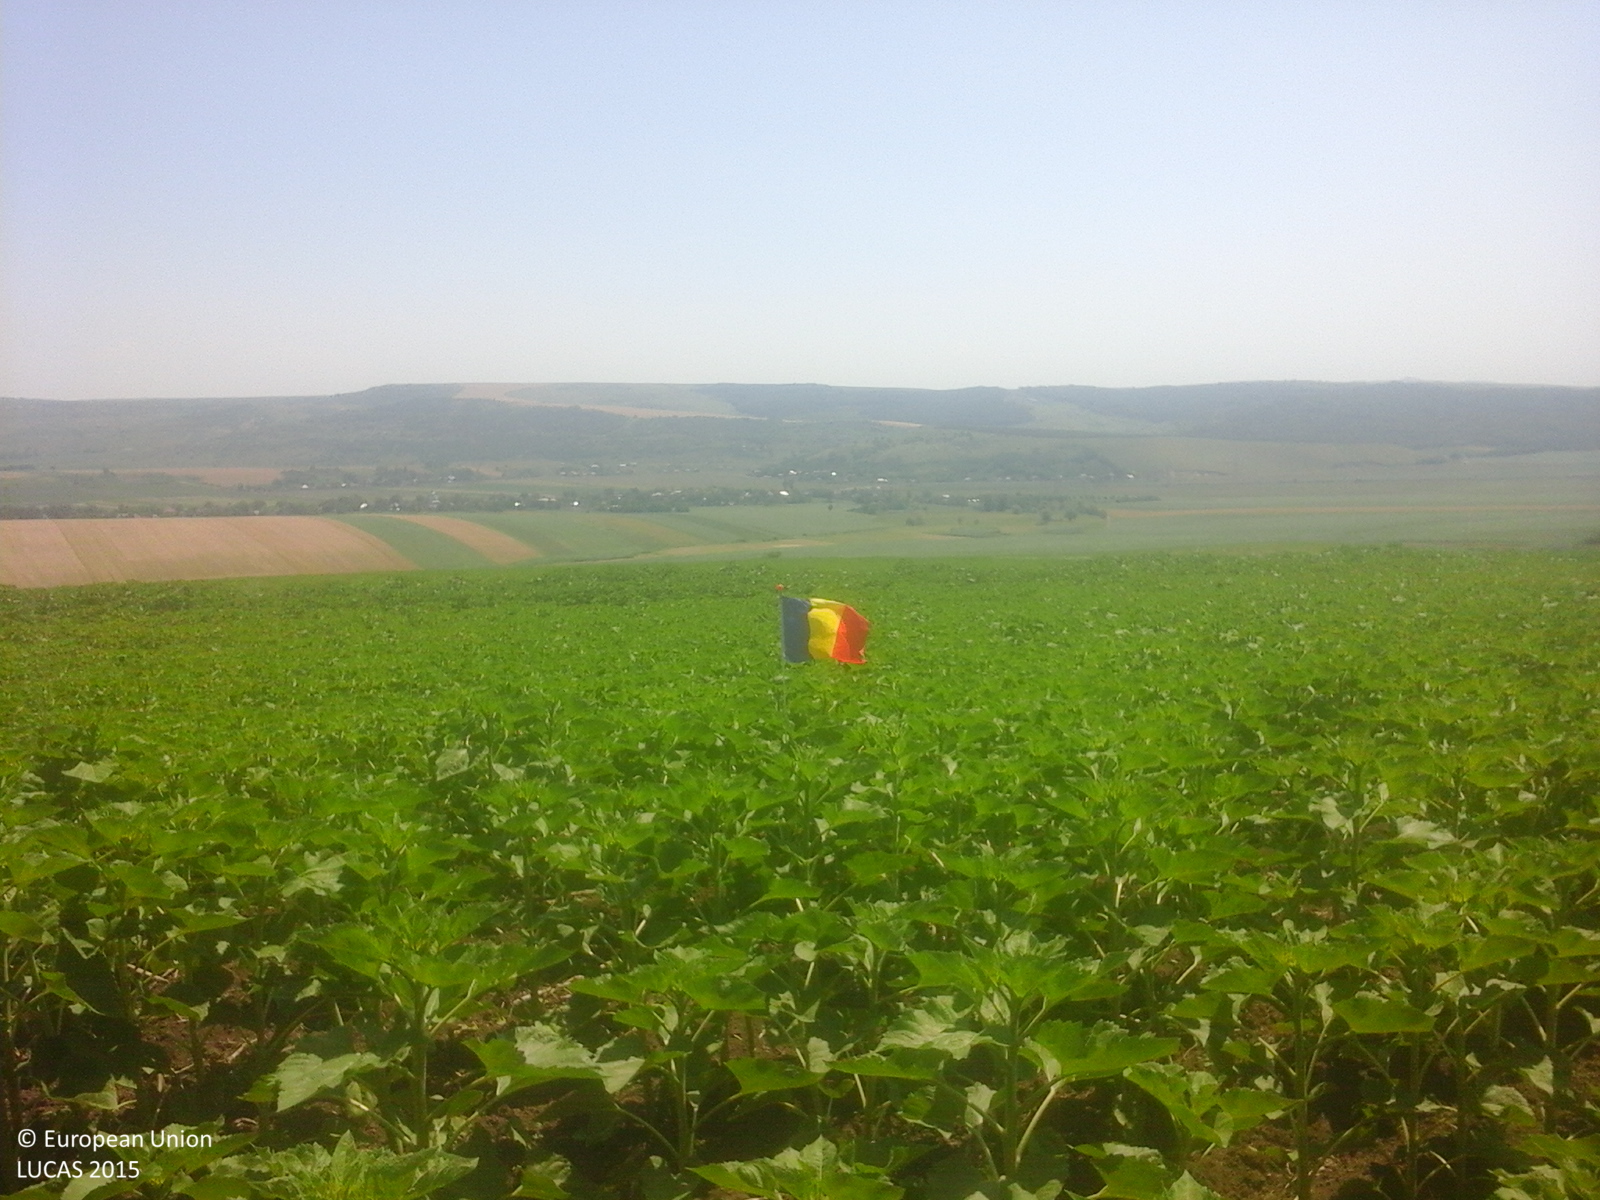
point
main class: Cropland
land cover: Sunflower
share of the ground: > 75 %
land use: Agriculture (excluding fallow land and kitchen gardens)
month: June
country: RO
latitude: 46.8391
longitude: 27.5403
